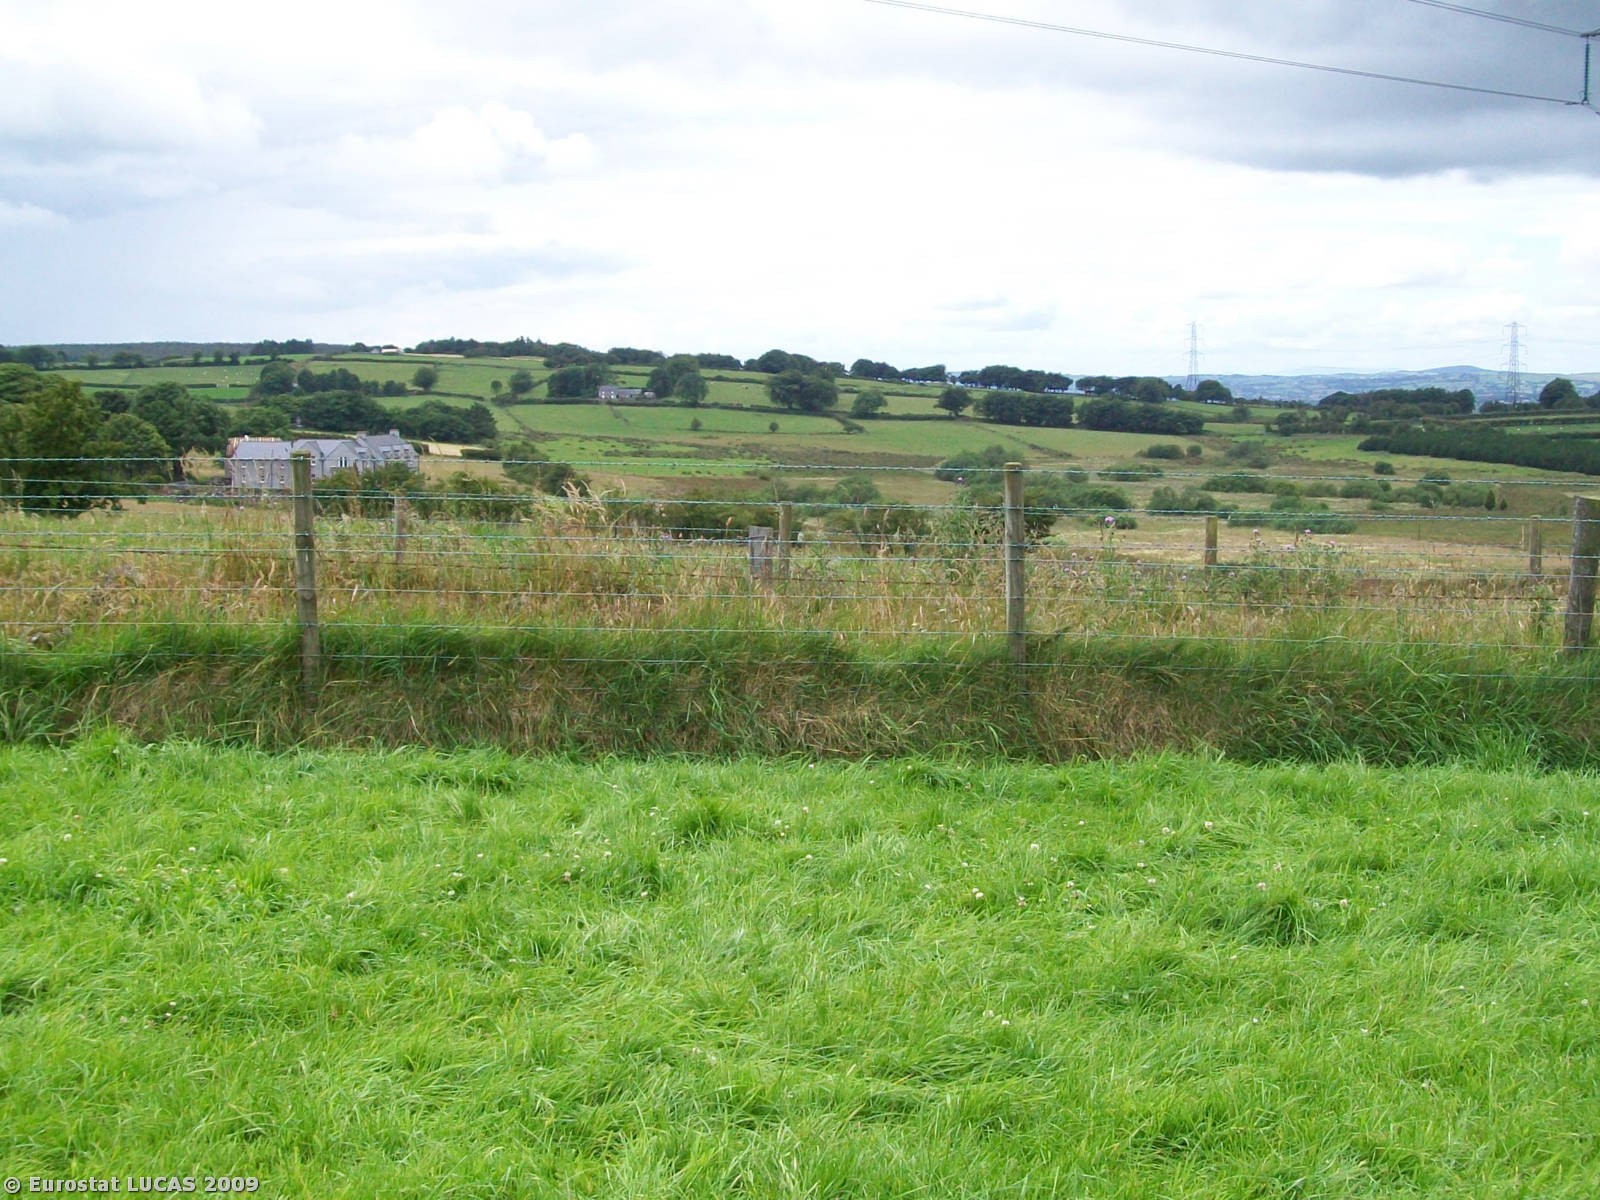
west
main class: Grassland
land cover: Grassland without tree/shrub cover
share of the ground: > 75 %
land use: Agriculture (excluding fallow land and kitchen gardens)
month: July
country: GB
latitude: 54.7707
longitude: -5.8514
